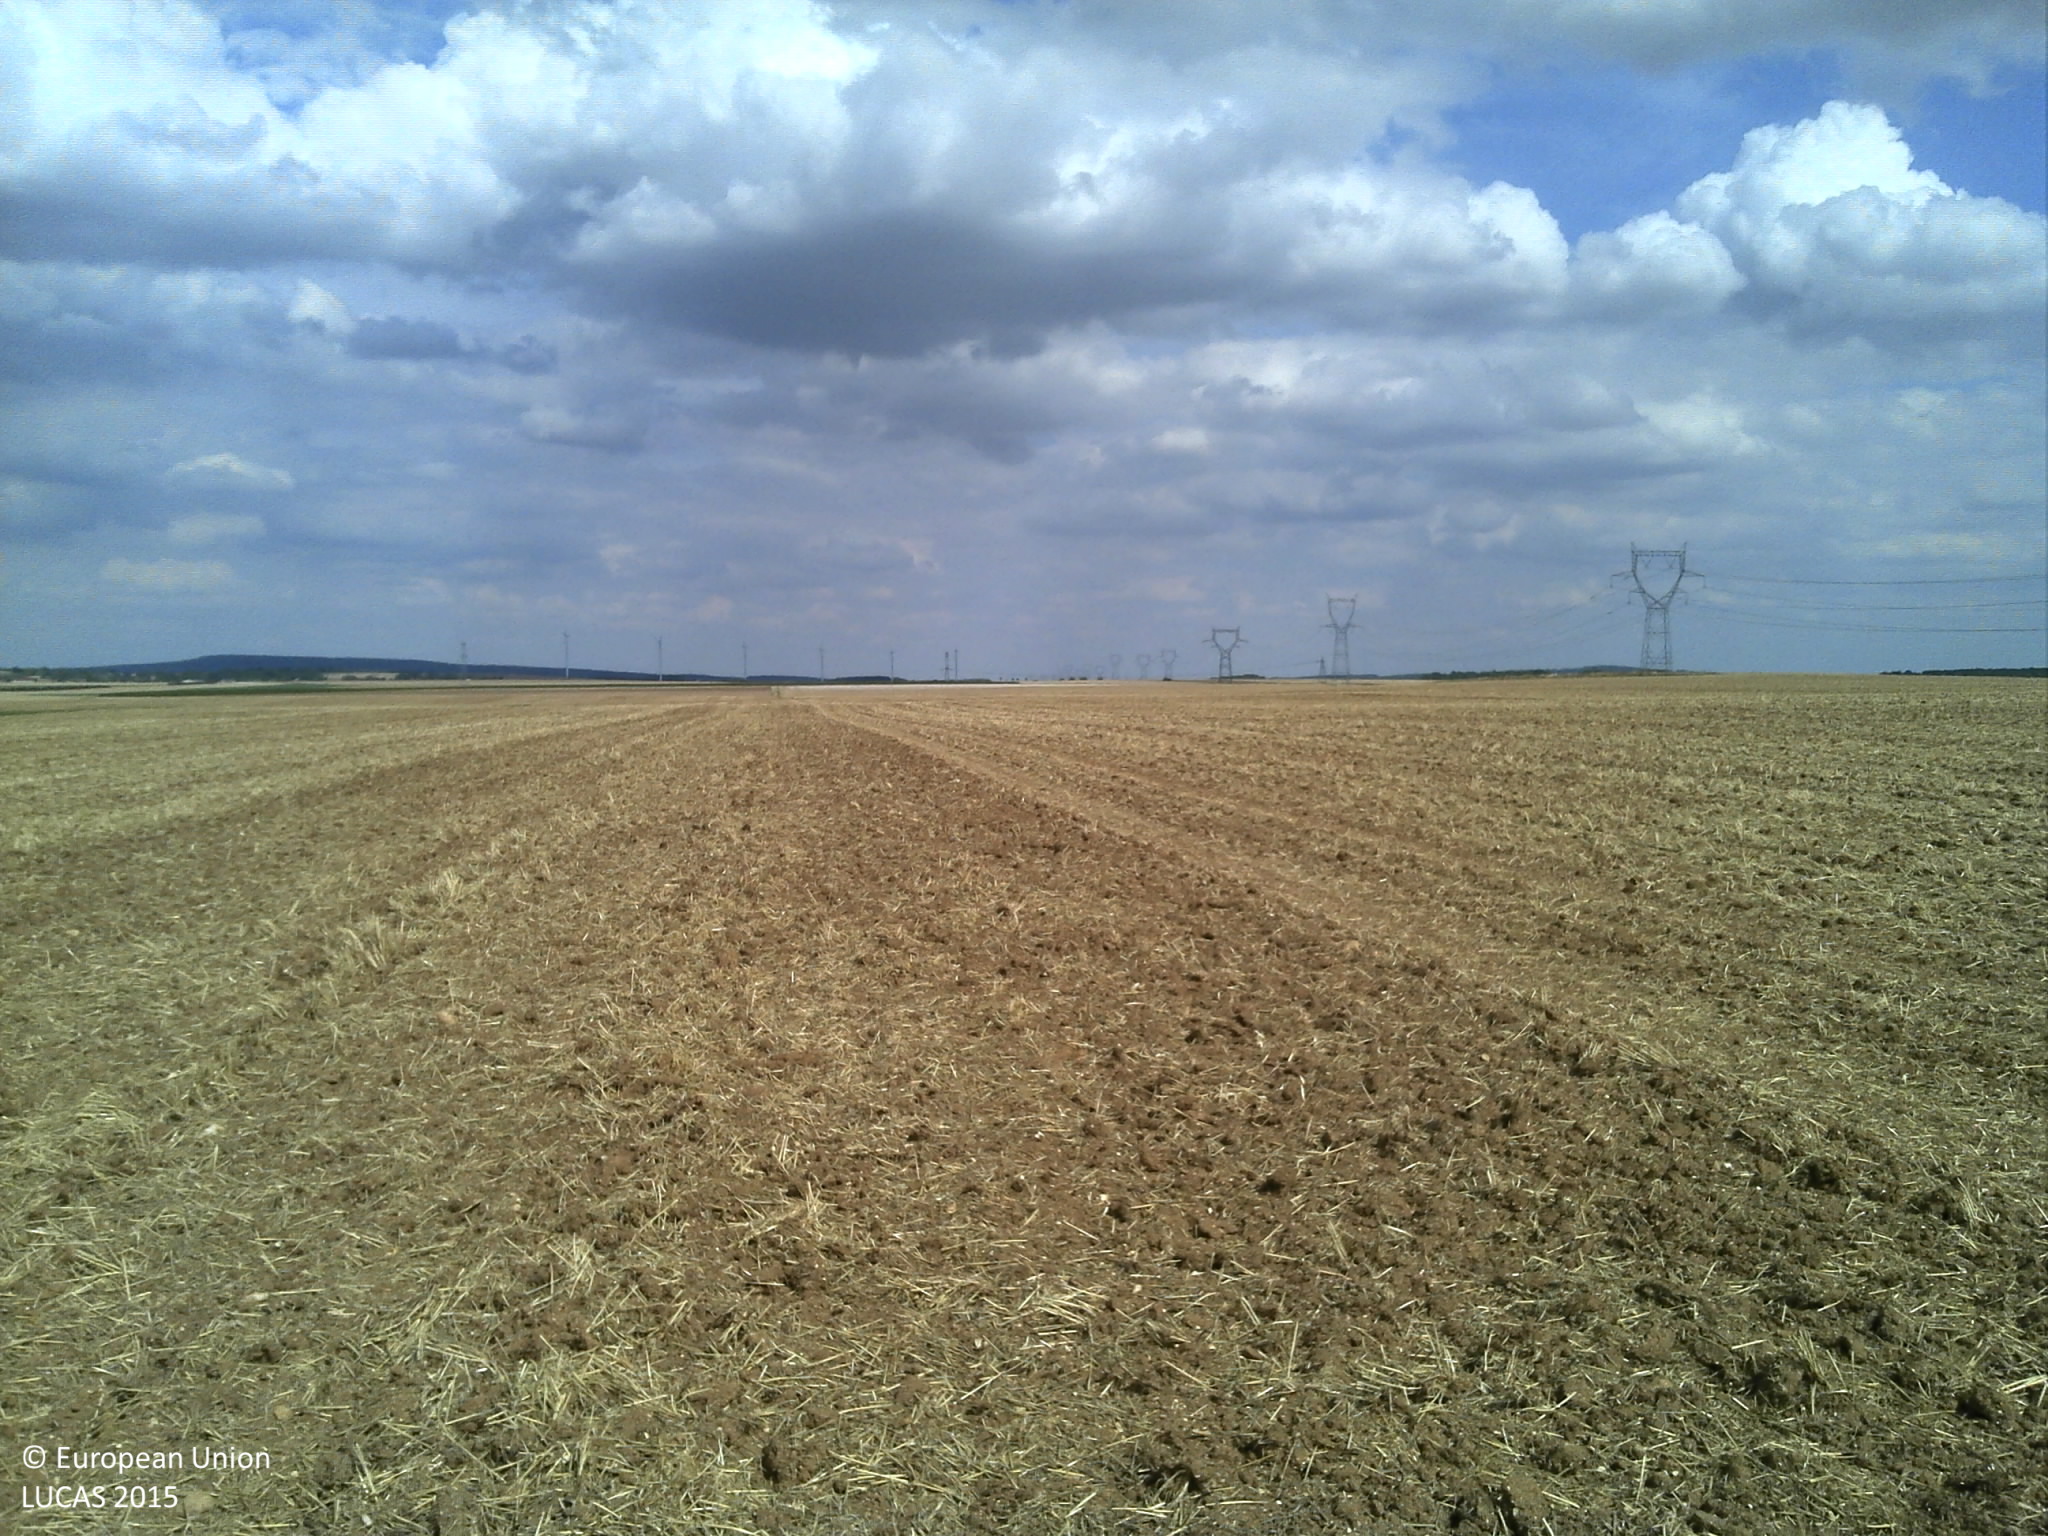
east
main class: Cropland
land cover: Common wheat
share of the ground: 25 - 50 %
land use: Agriculture (excluding fallow land and kitchen gardens)
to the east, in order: Common wheat
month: August
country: FR
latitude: 48.4447
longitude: 3.4643
